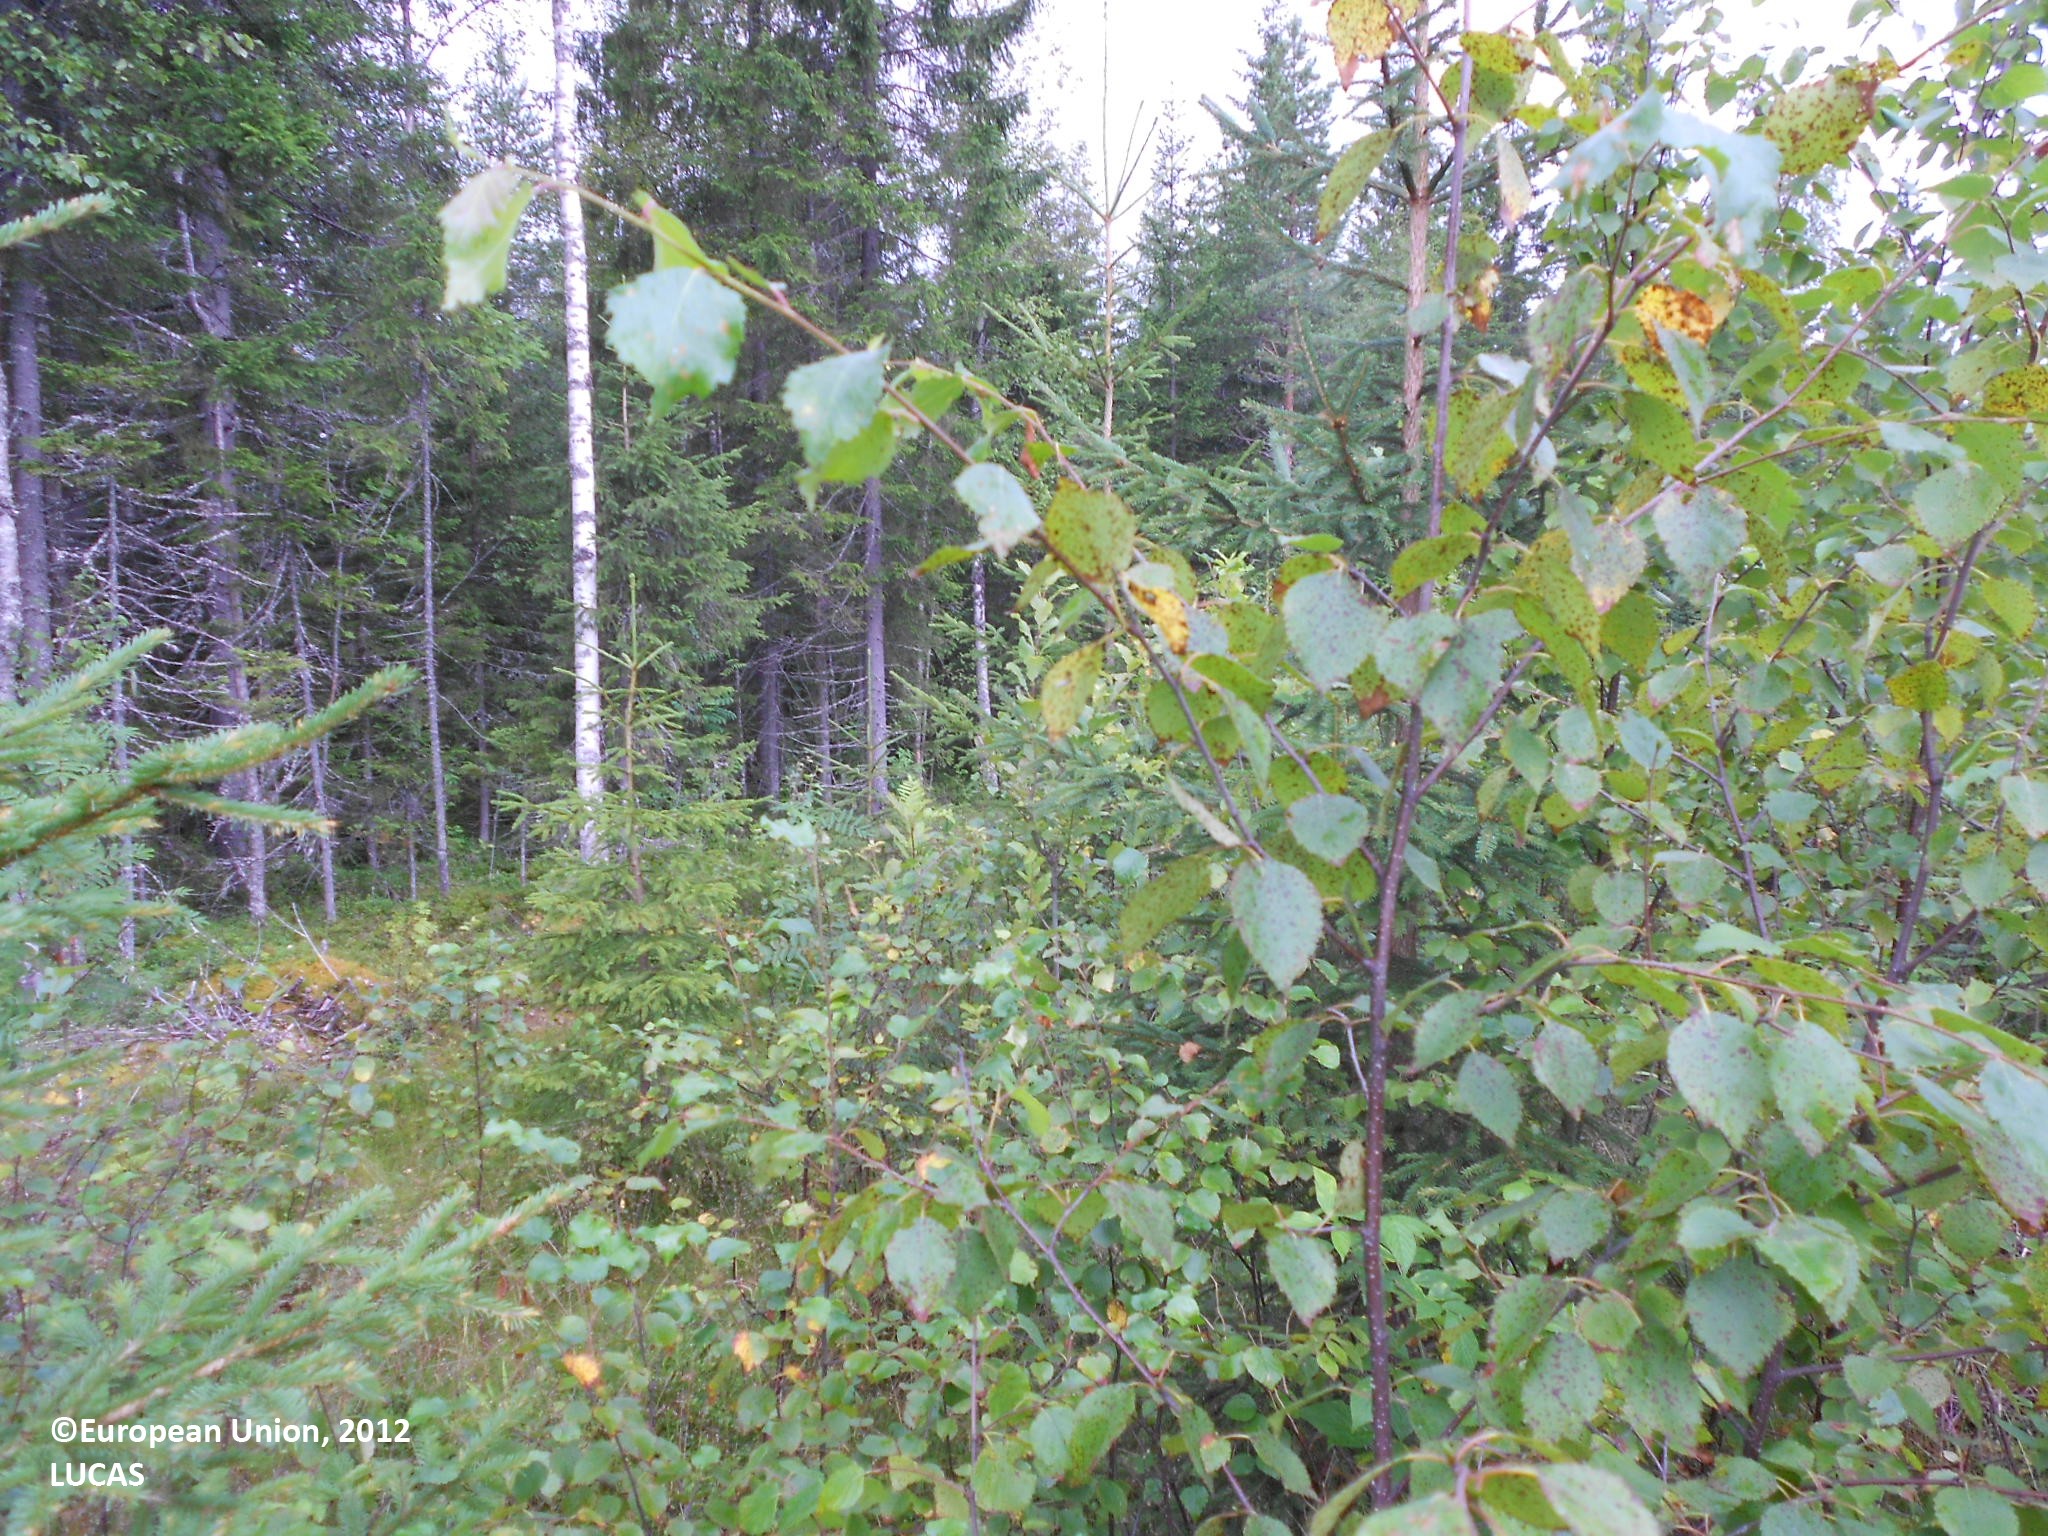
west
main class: Woodland
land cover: Spruce dominated mixed woodland
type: boreal forest
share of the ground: 50 - 75 %
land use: Forestry
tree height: < 5 m
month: August
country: FI
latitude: 63.3764
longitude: 28.7409
